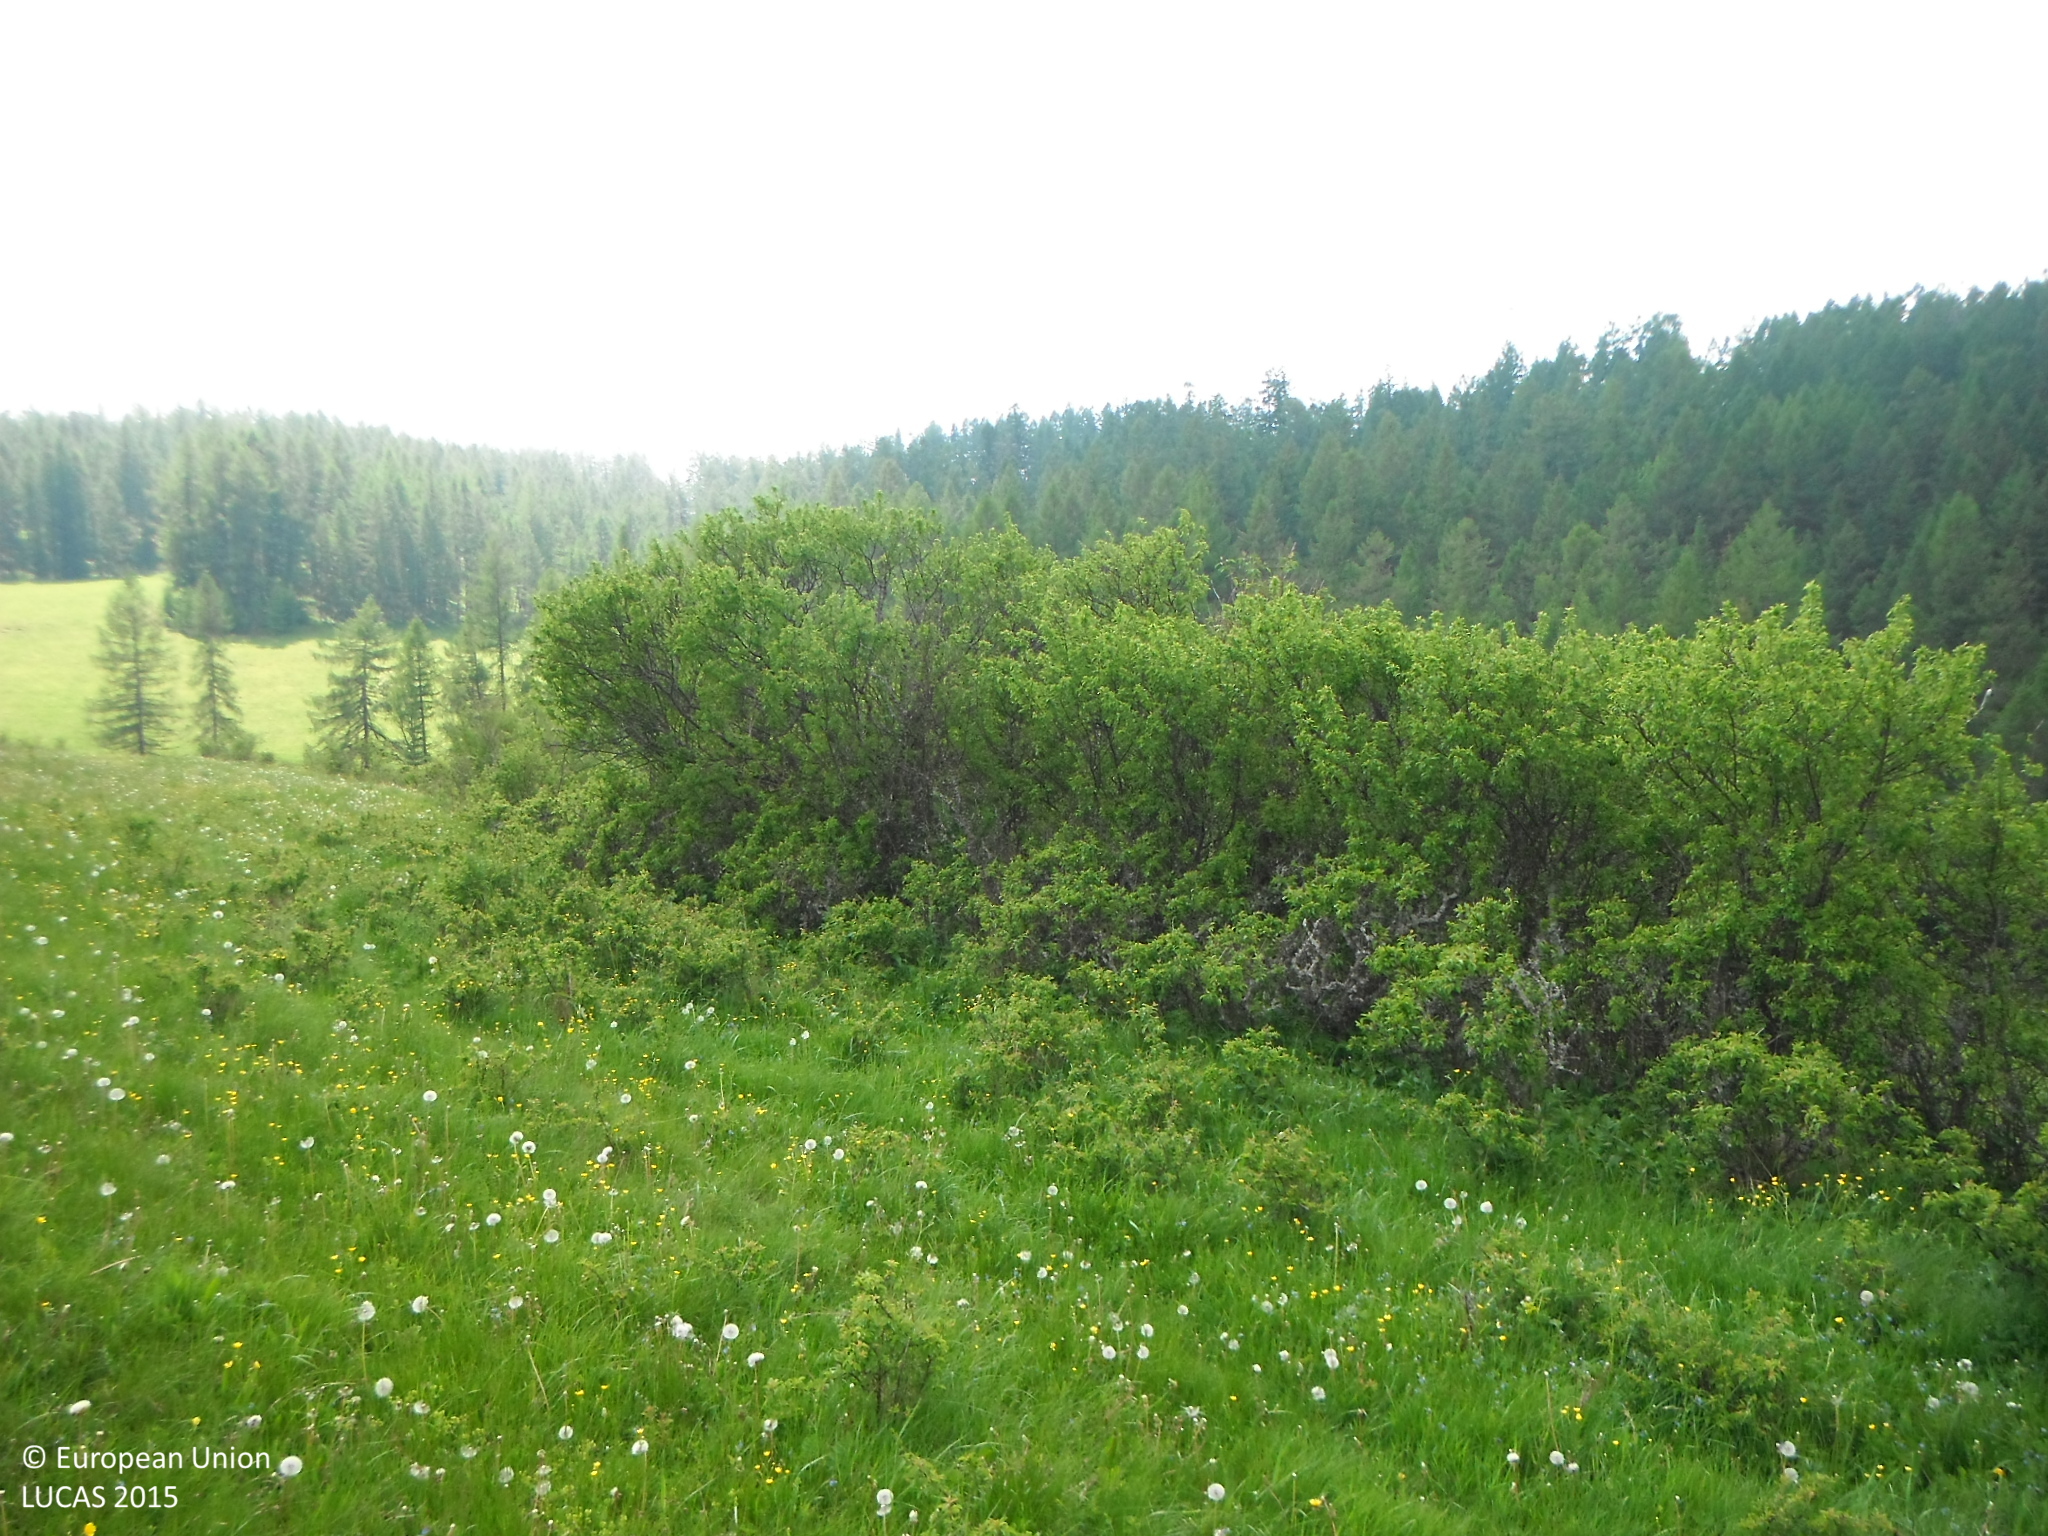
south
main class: Grassland
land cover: Grassland without tree/shrub cover
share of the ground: > 75 %
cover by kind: herbaceous plants 100 %
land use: Agriculture (excluding fallow land and kitchen gardens)
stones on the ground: < 10 %
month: June
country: SK
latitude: 49.0801
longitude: 20.7037
